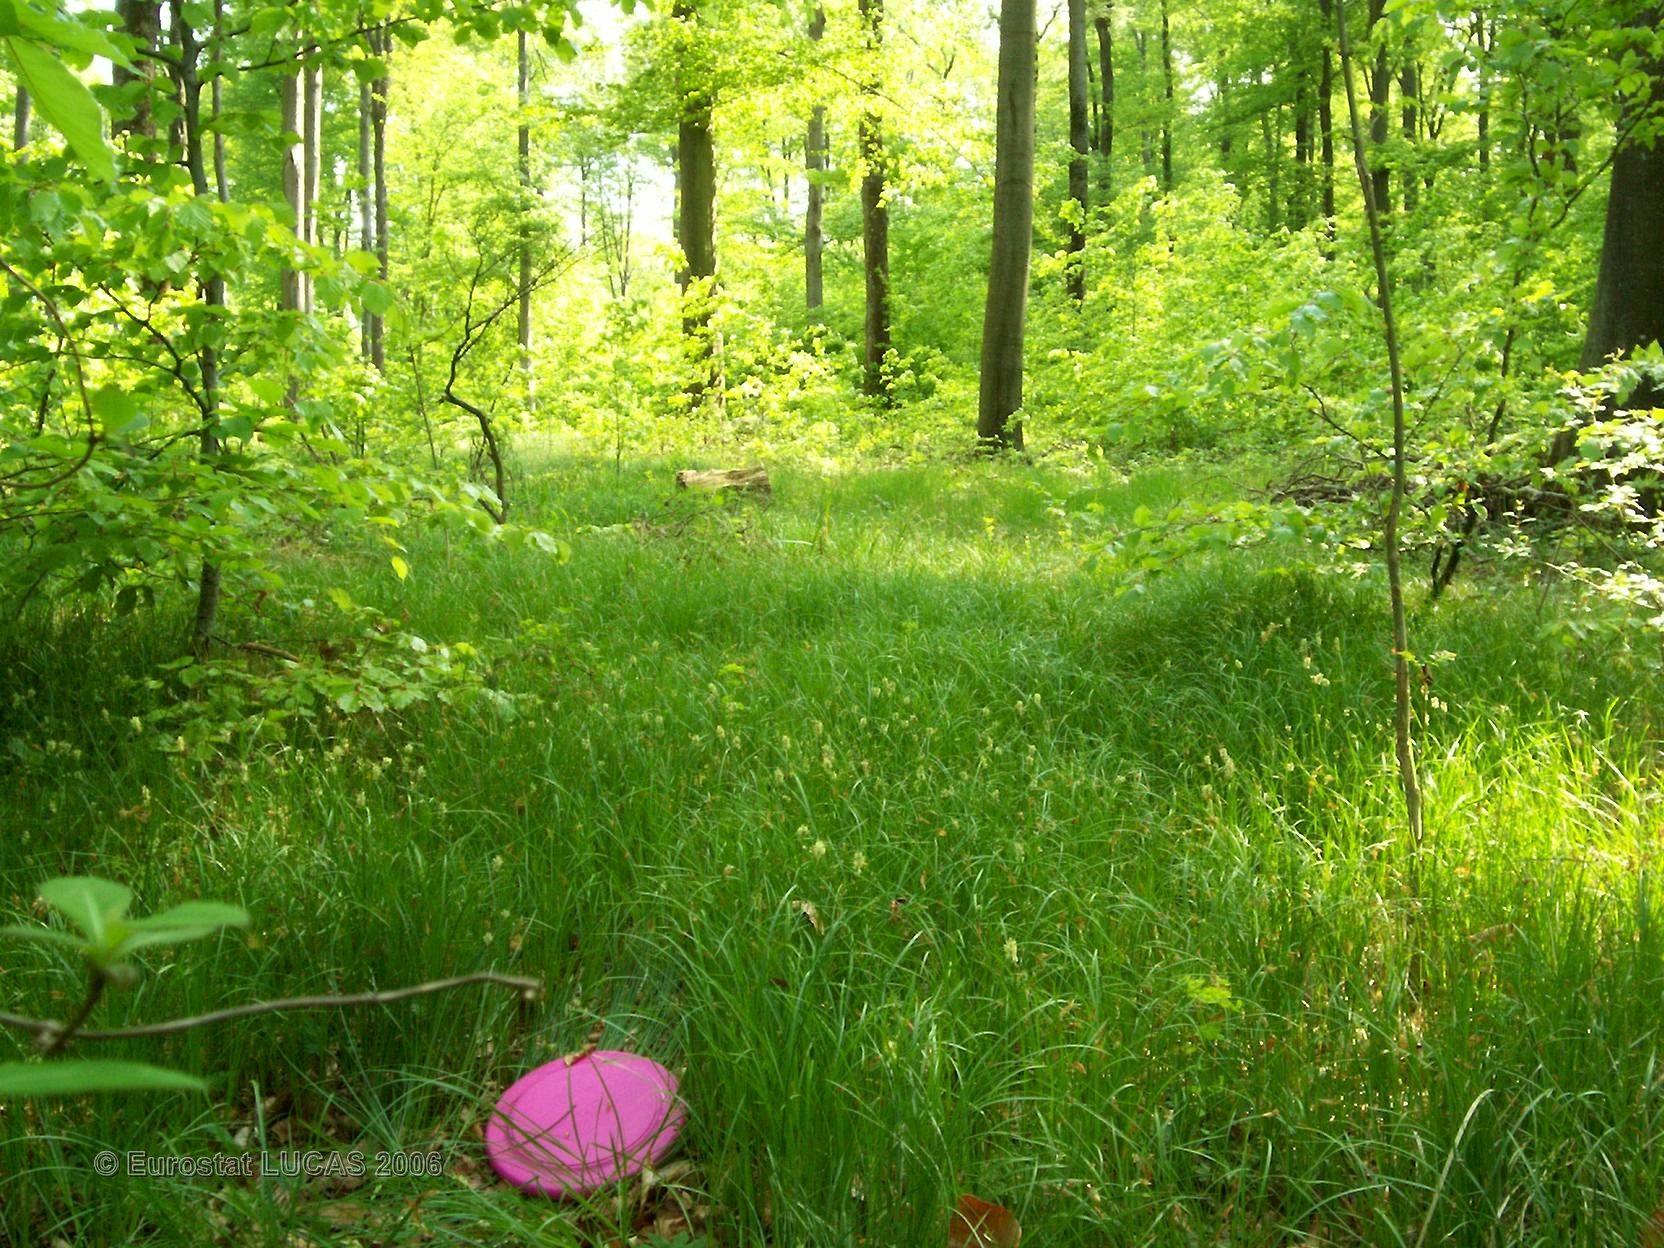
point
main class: Woodland
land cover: Broadleaved forest
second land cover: Grassland with sparse tree/shrub cover
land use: Forestry
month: May
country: FR
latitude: 47.7002
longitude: 7.1365
